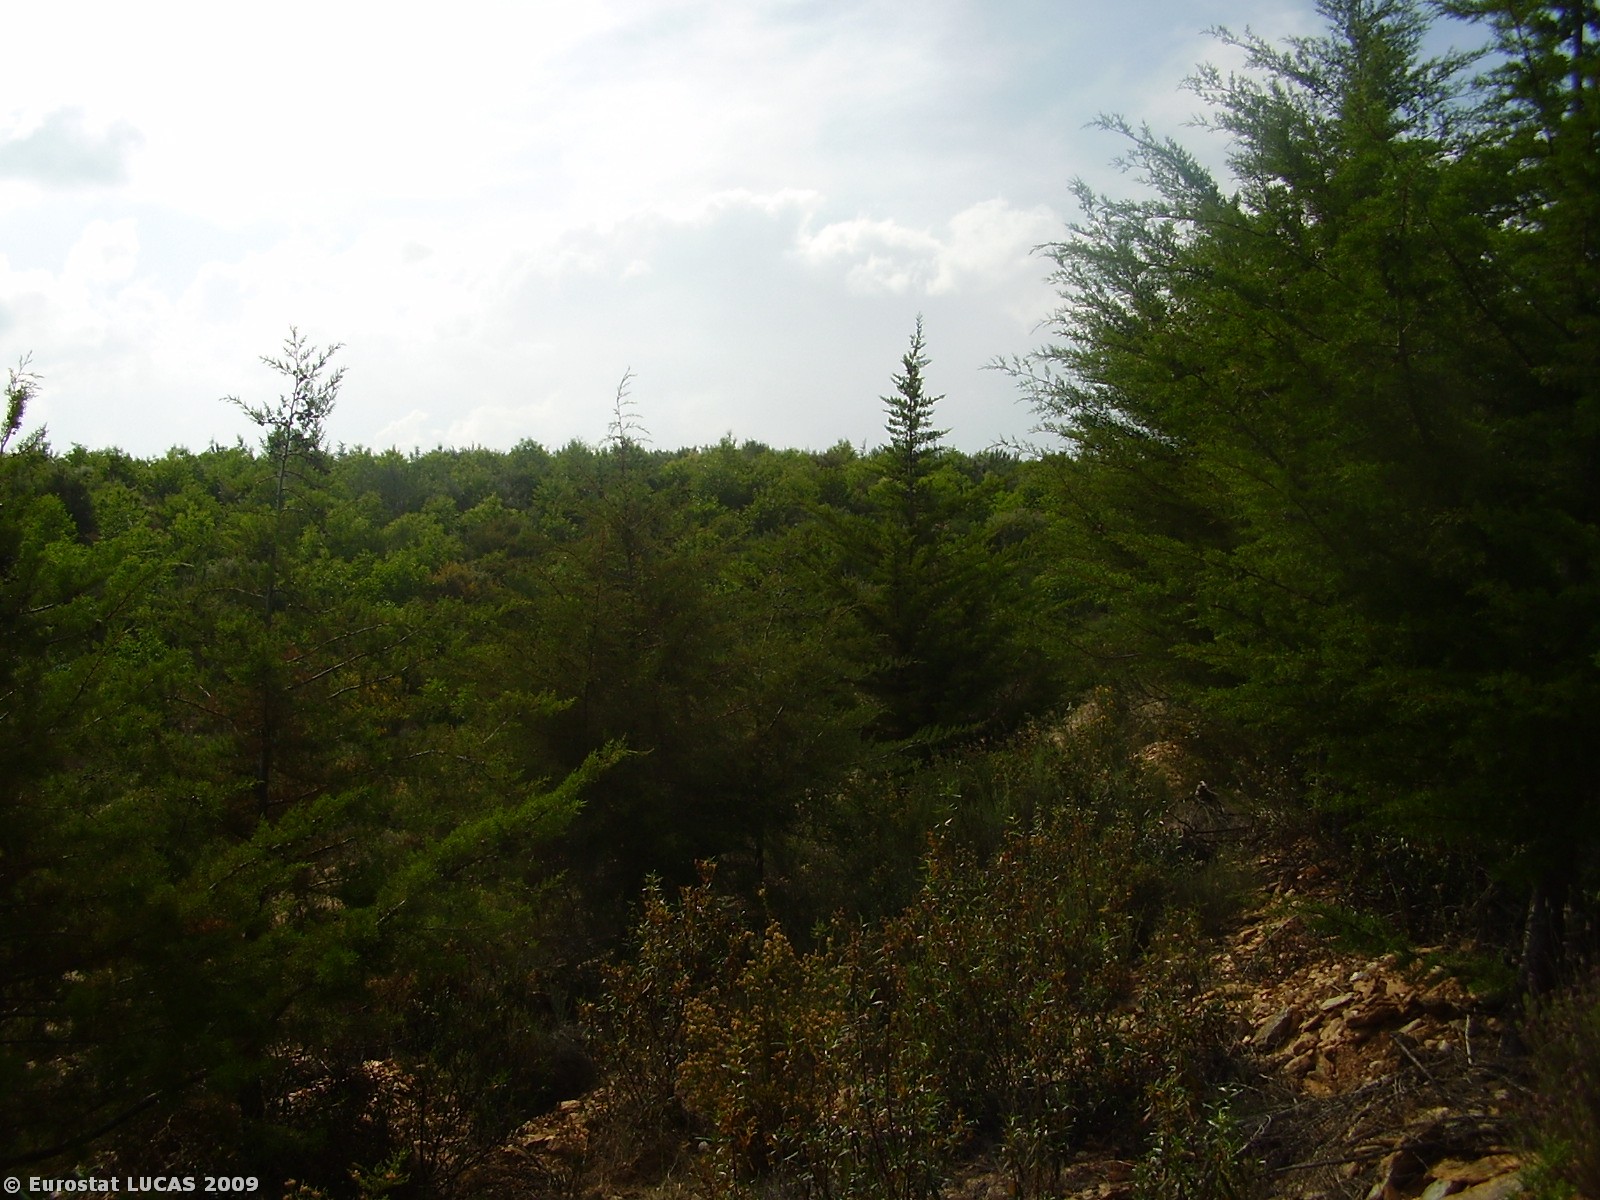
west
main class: Woodland
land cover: Coniferous woodland
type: coniferous forest of the mediterranean region
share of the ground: < 10 %
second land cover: Shrubland with sparse tree cover
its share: 50 - 75 %
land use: Forestry
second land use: Nature reserves
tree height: > 5 m
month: June
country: PT
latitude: 41.5947
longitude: -6.8726
